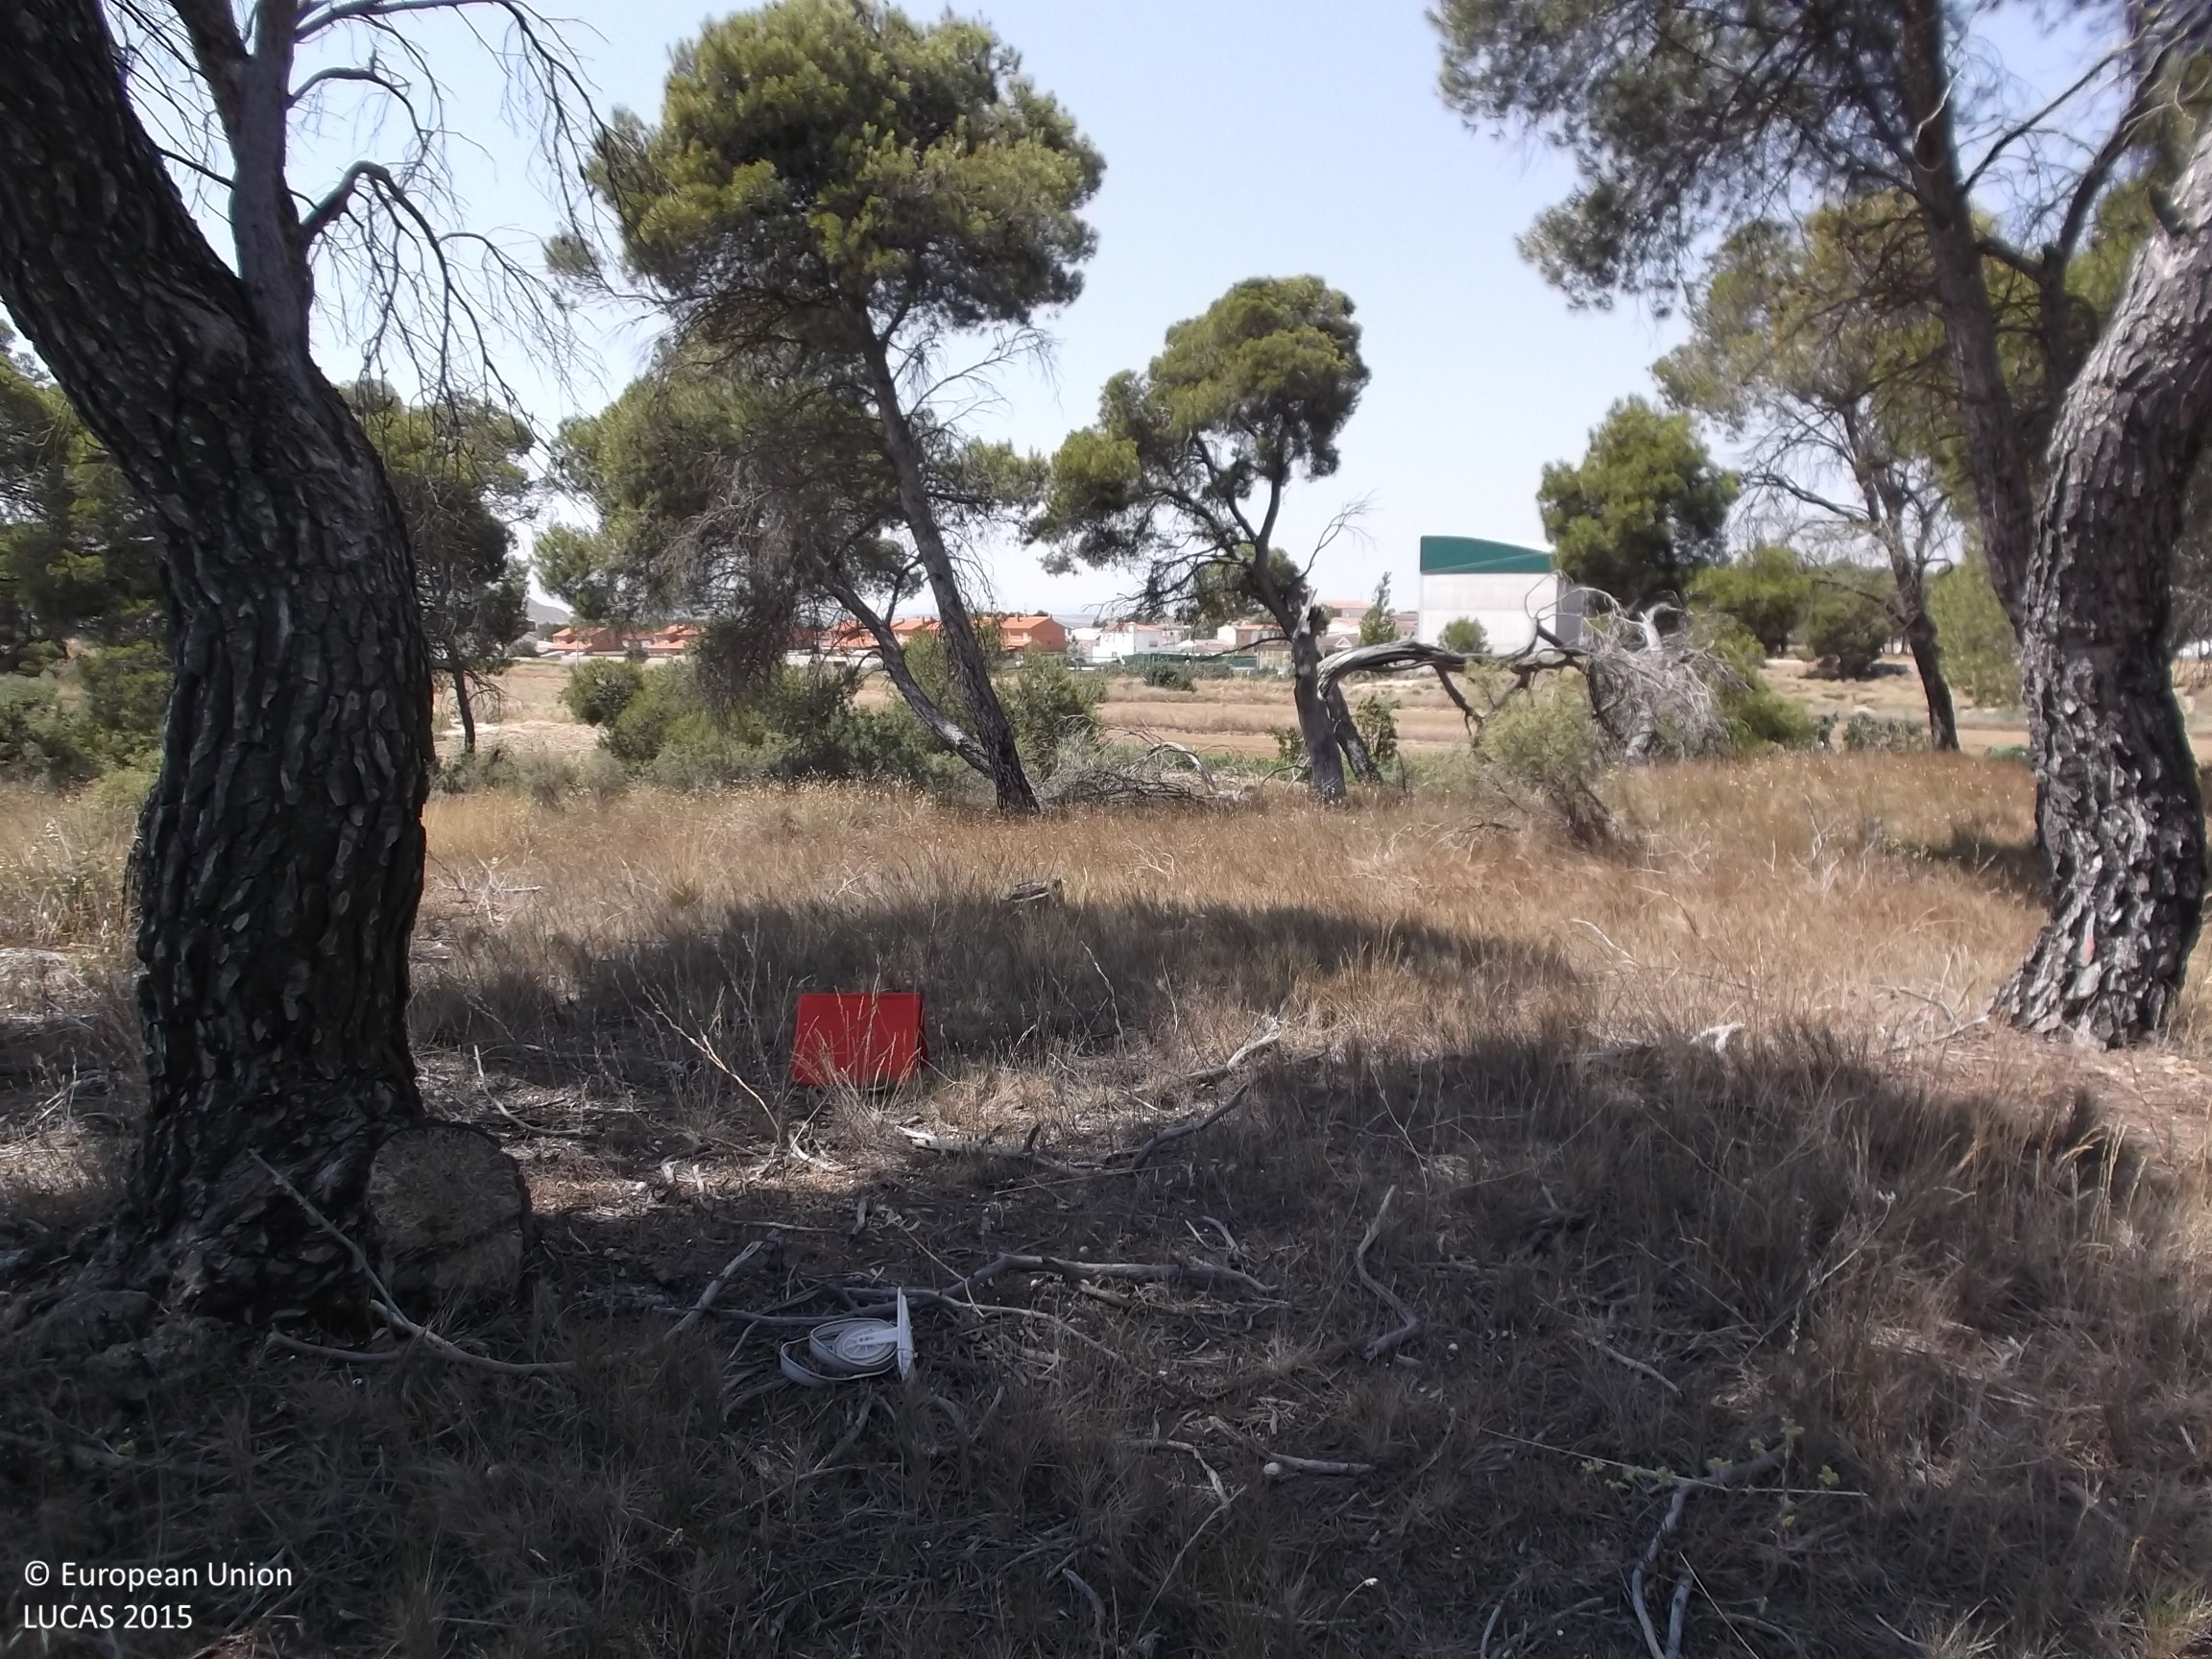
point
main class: Woodland
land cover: Pine dominated coniferous woodland
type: coniferous forest of the mediterranean region
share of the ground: 25 - 50 %
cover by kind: coniferous forest trees 40 %, herbaceous plants 30 %, unconsolidated bare surface 25 %
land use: Semi-natural and natural areas not in use
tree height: > 5 m
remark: Burnt area
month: July
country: ES
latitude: 42.3164
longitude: -1.5725
